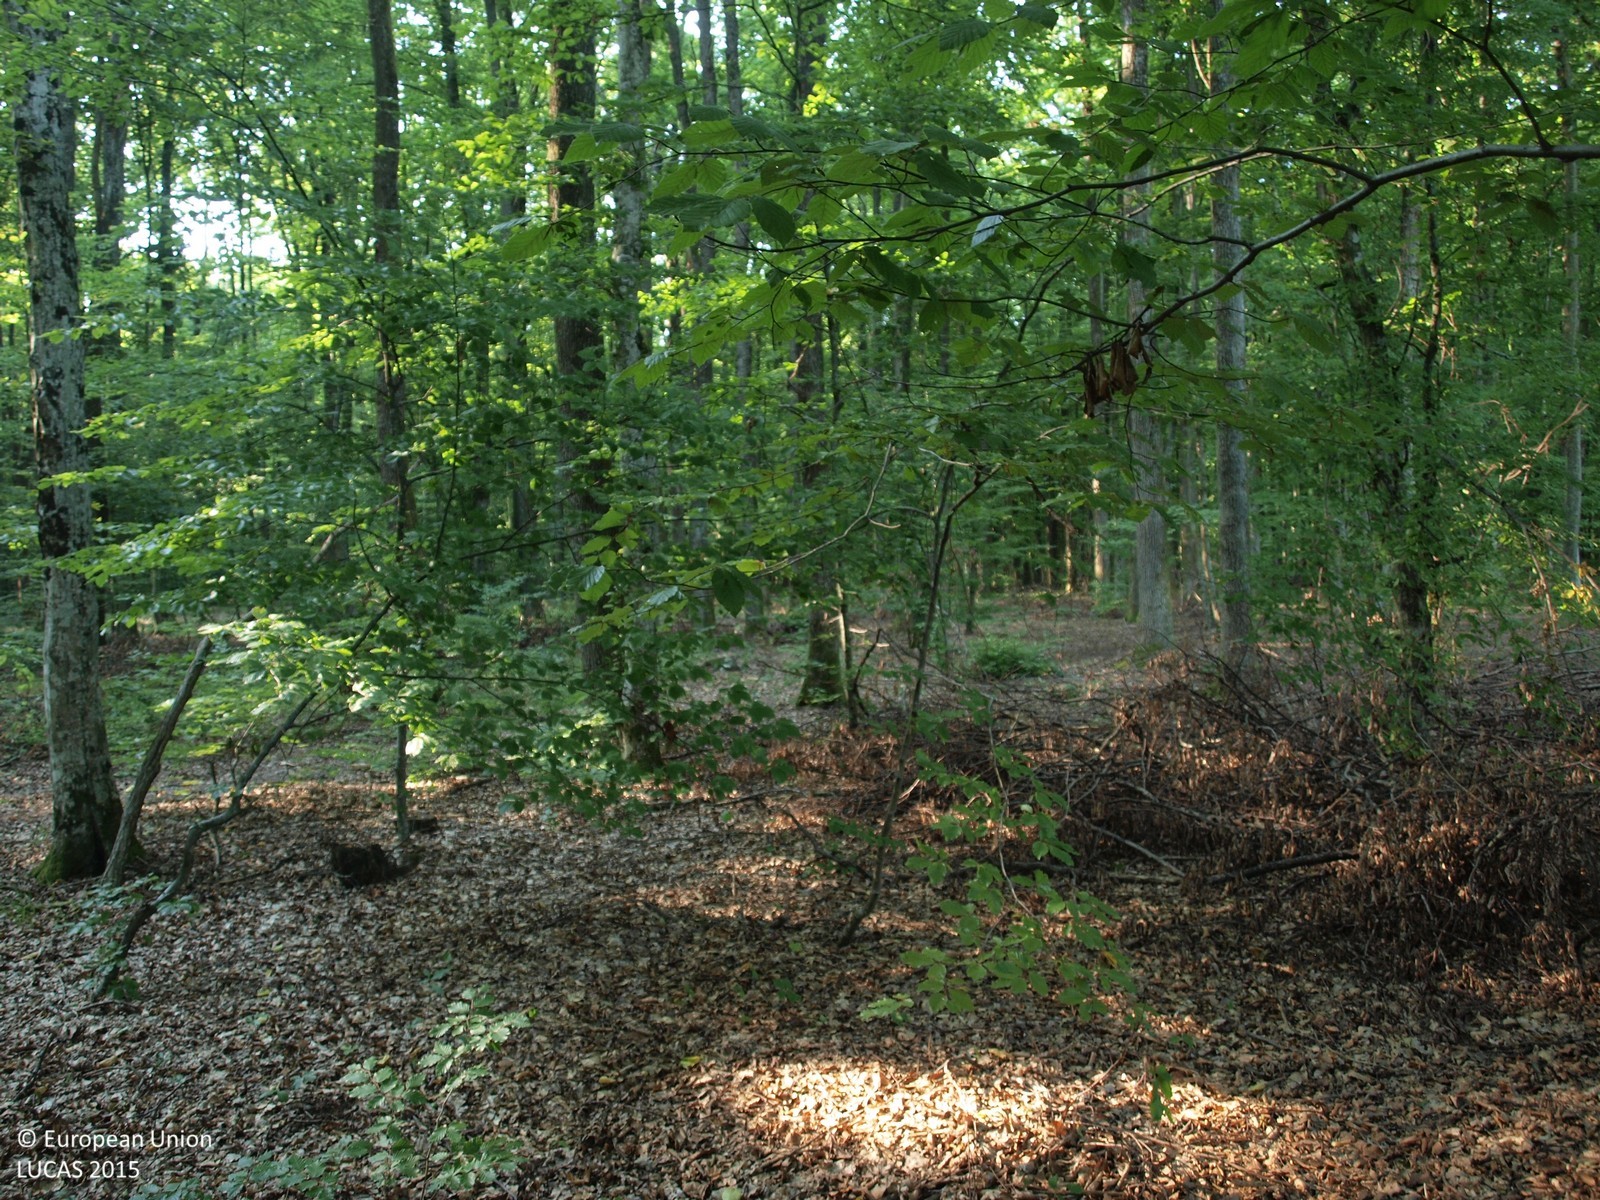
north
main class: Woodland
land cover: Broadleaved woodland
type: mesophytic deciduous forest
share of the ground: > 75 %
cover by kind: broadleaved forest trees 100 %
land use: Forestry
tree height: > 5 m
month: August
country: HR
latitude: 45.8609
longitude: 16.5555
